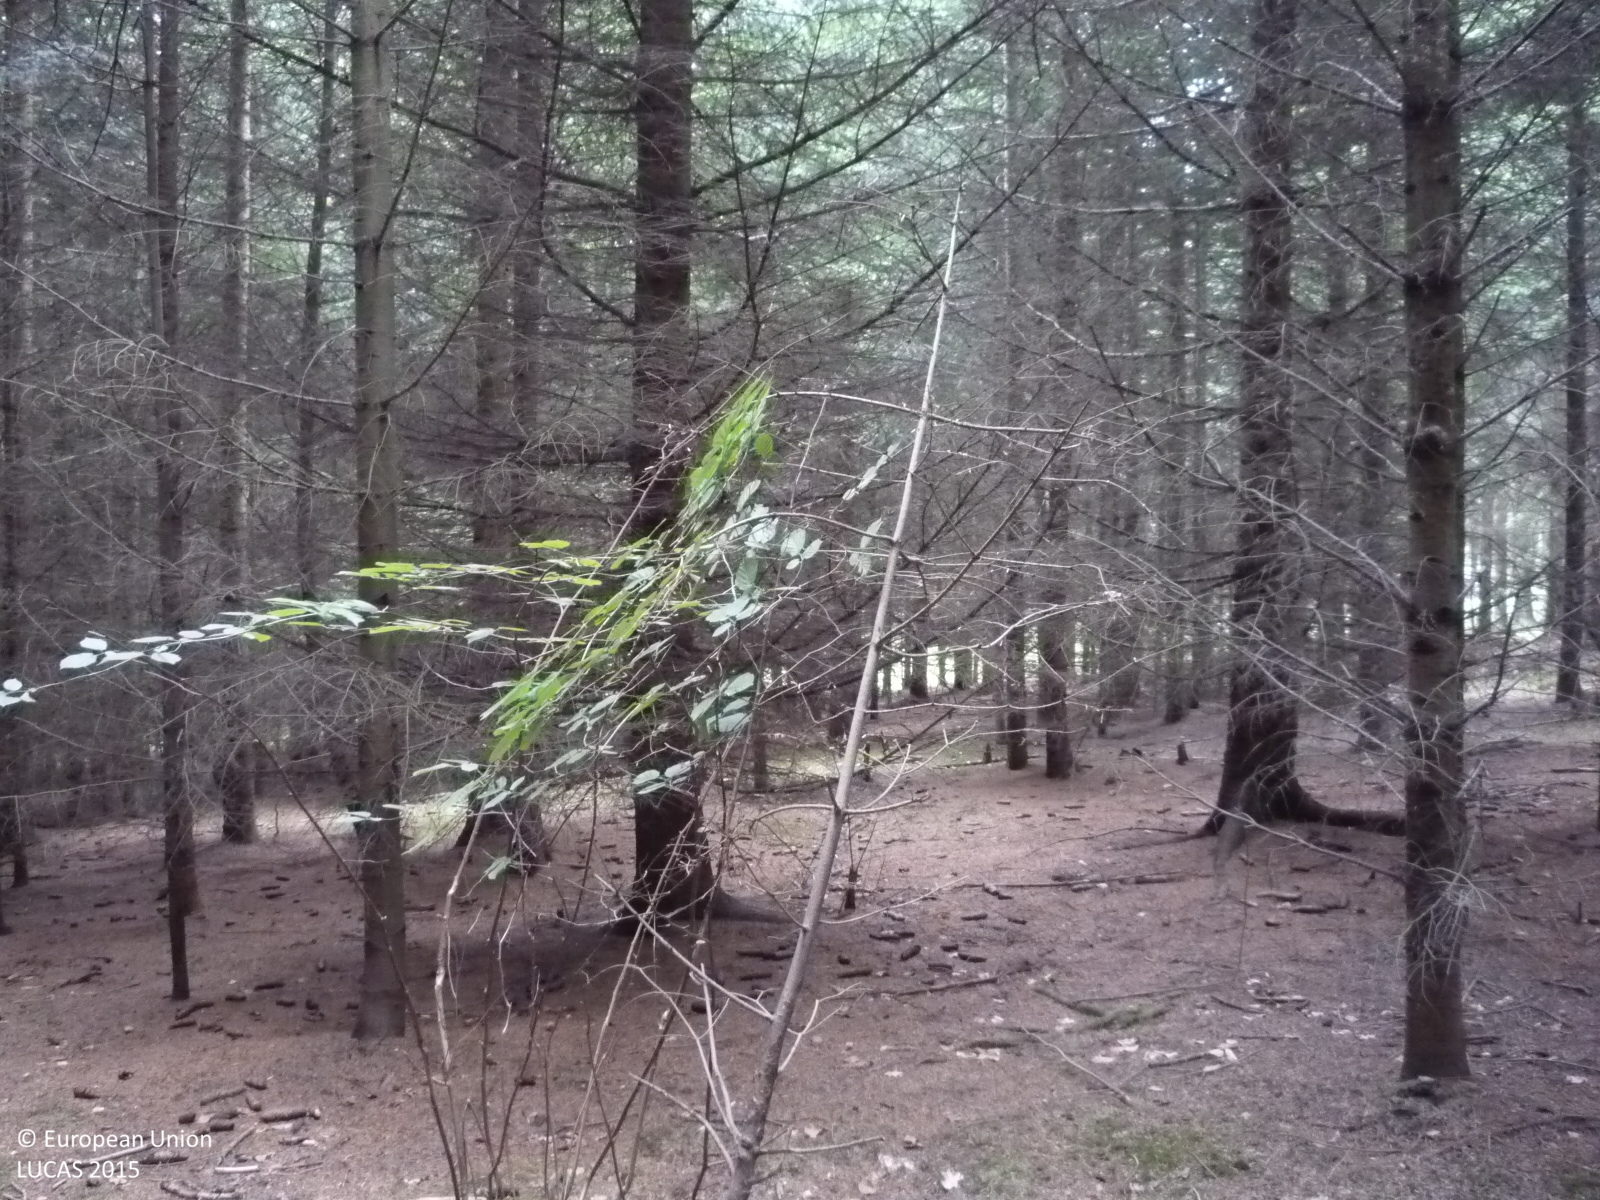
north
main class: Woodland
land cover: Other coniferous woodland
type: hemiboreal forest and nemoral coniferous forest and mixed broadleaved-coniferous forest
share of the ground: > 75 %
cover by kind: coniferous forest trees 95 %, broadleaved forest trees 5 %
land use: Forestry
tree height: > 5 m
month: June
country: CZ
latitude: 49.7422
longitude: 15.1791
